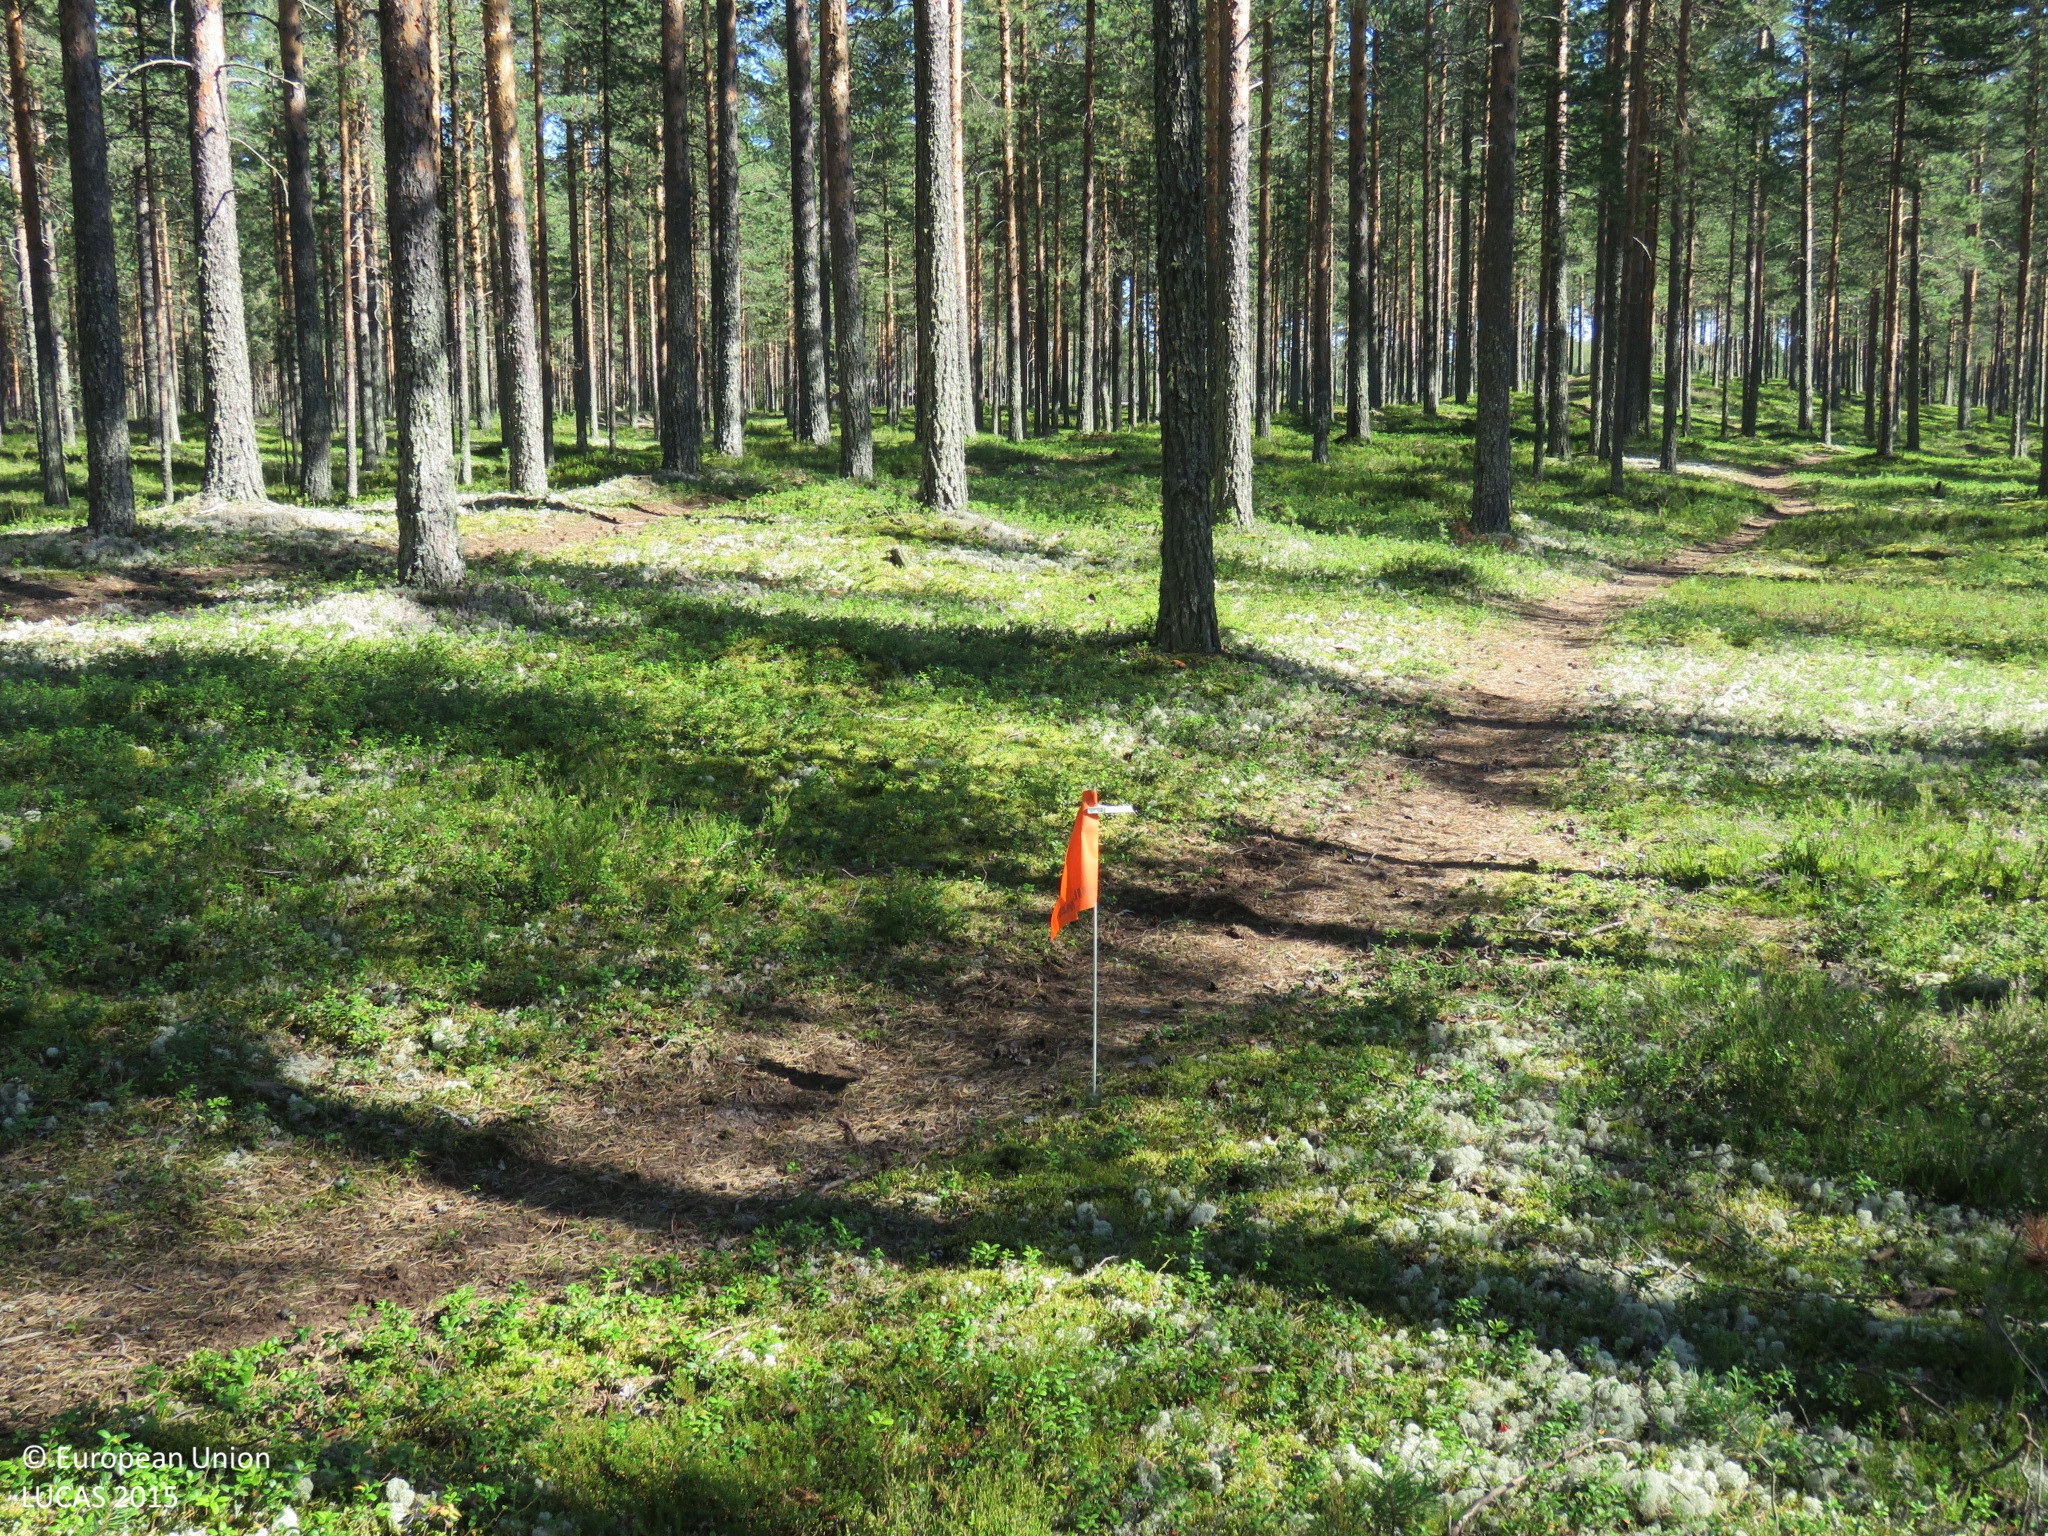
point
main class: Woodland
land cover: Pine dominated coniferous woodland
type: boreal forest
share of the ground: > 75 %
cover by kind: coniferous forest trees 75 %, shrubs 10 %, lichens and mosses 10 %, unconsolidated bare surface 5 %
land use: Forestry
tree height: > 5 m
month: August
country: FI
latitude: 65.1130
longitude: 25.6537
